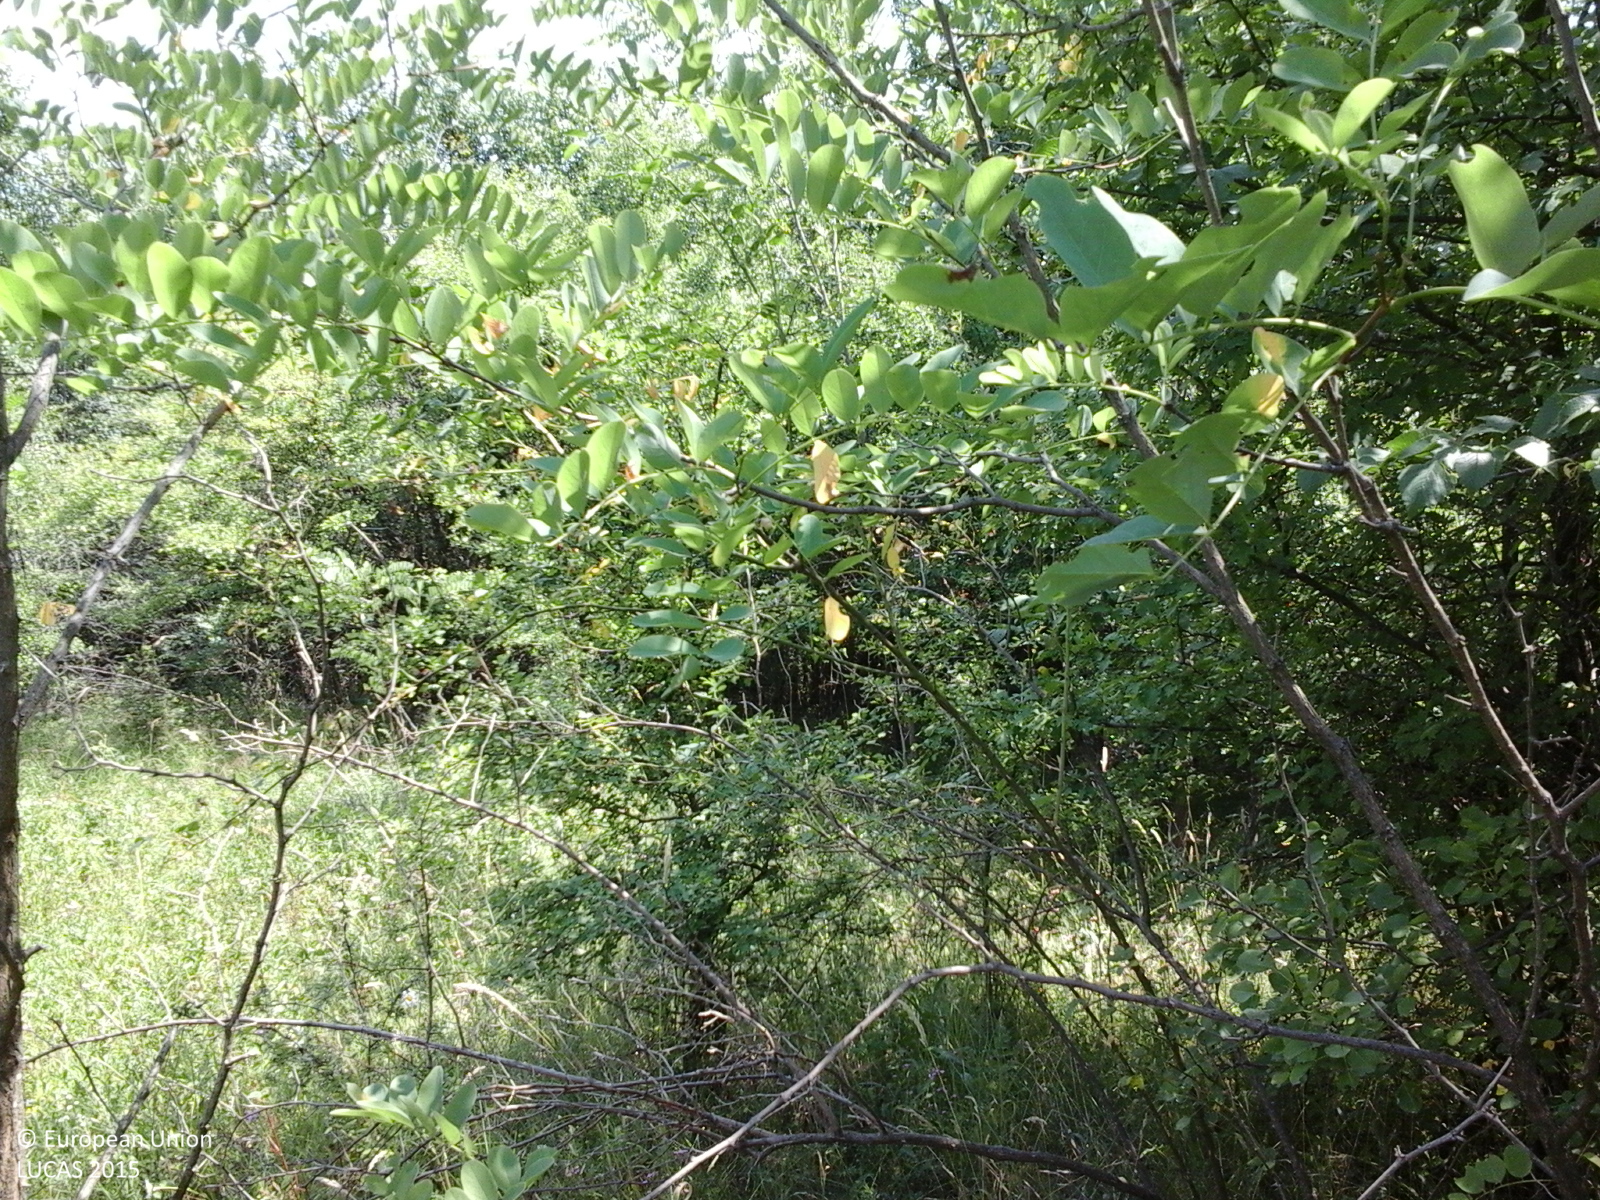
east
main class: Woodland
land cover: Broadleaved woodland
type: acidophilous oak and oak-birch forest
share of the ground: > 75 %
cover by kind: broadleaved forest trees 100 %
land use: Forestry
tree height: > 5 m
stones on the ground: < 10 %
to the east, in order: Broadleaved woodland; Tracks; Spontaneously vegetated surfaces
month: July
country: RO
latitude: 44.7622
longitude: 24.5655
